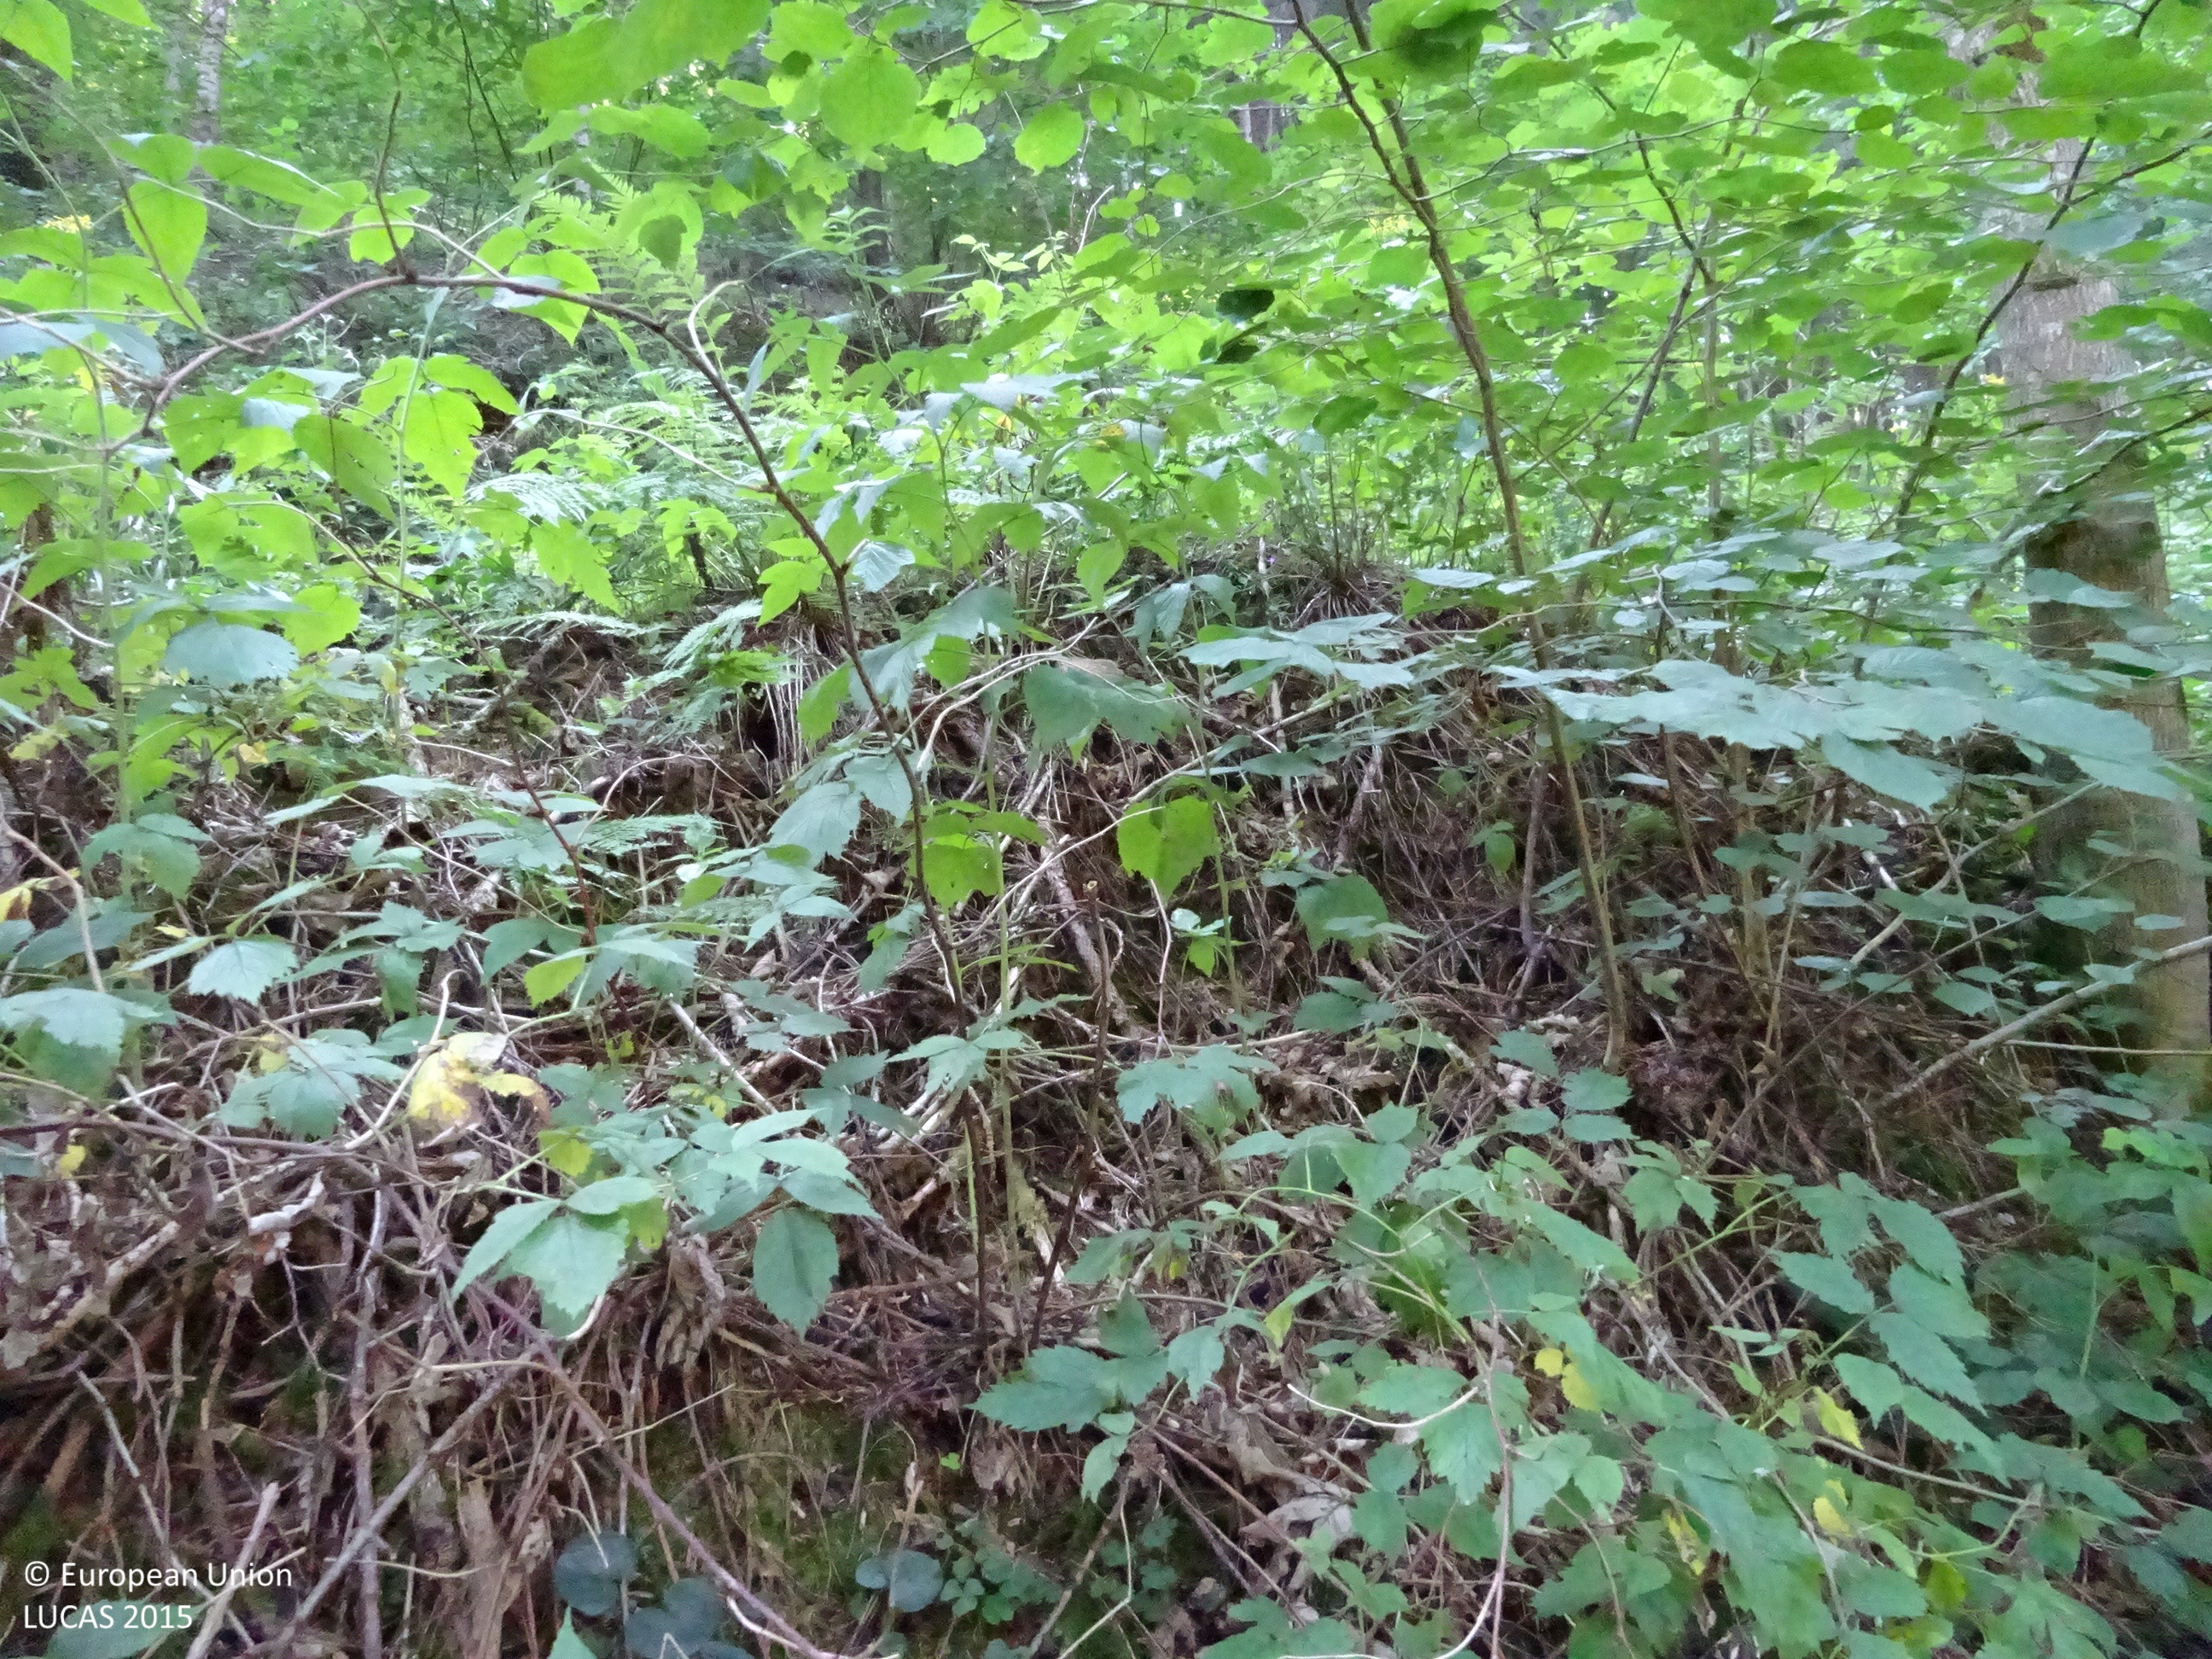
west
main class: Woodland
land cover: Spruce dominated mixed woodland
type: alpine coniferous forest
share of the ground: > 75 %
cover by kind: coniferous forest trees 50 %, broadleaved forest trees 40 %, shrubs 10 %
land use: Forestry
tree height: > 5 m
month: August
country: AT
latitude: 47.4116
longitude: 15.9791
